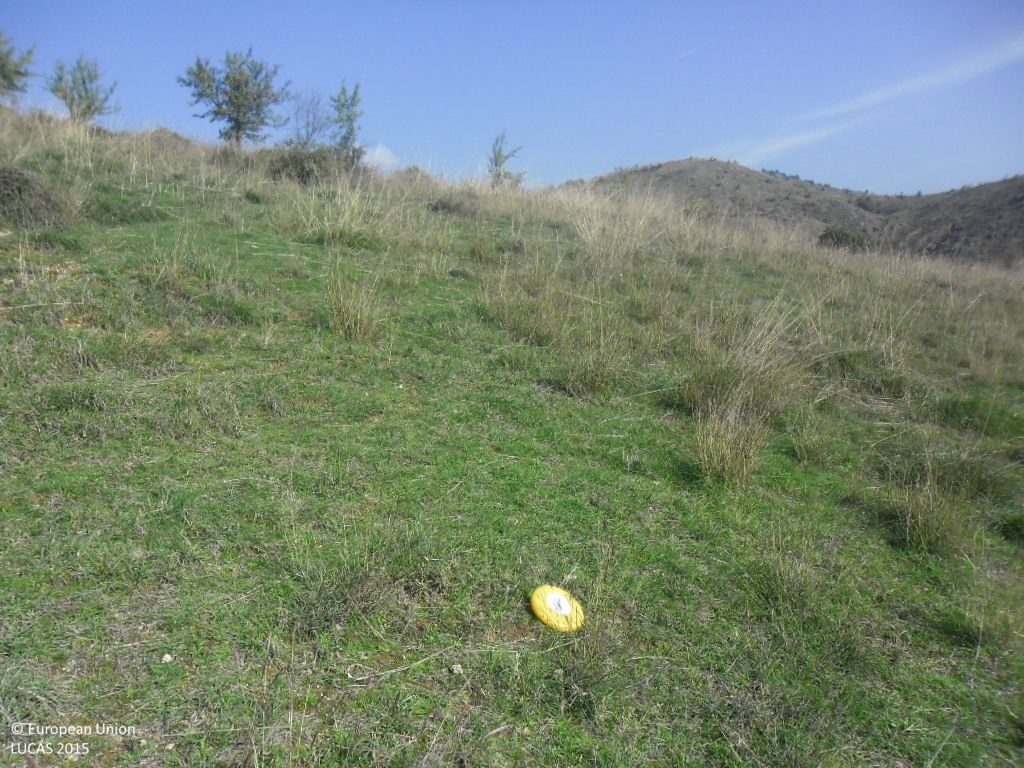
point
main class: Grassland
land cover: Grassland without tree/shrub cover
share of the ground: > 75 %
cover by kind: herbaceous plants 100 %
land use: Agriculture (excluding fallow land and kitchen gardens)
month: October
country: BG
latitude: 41.4600
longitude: 23.1767
